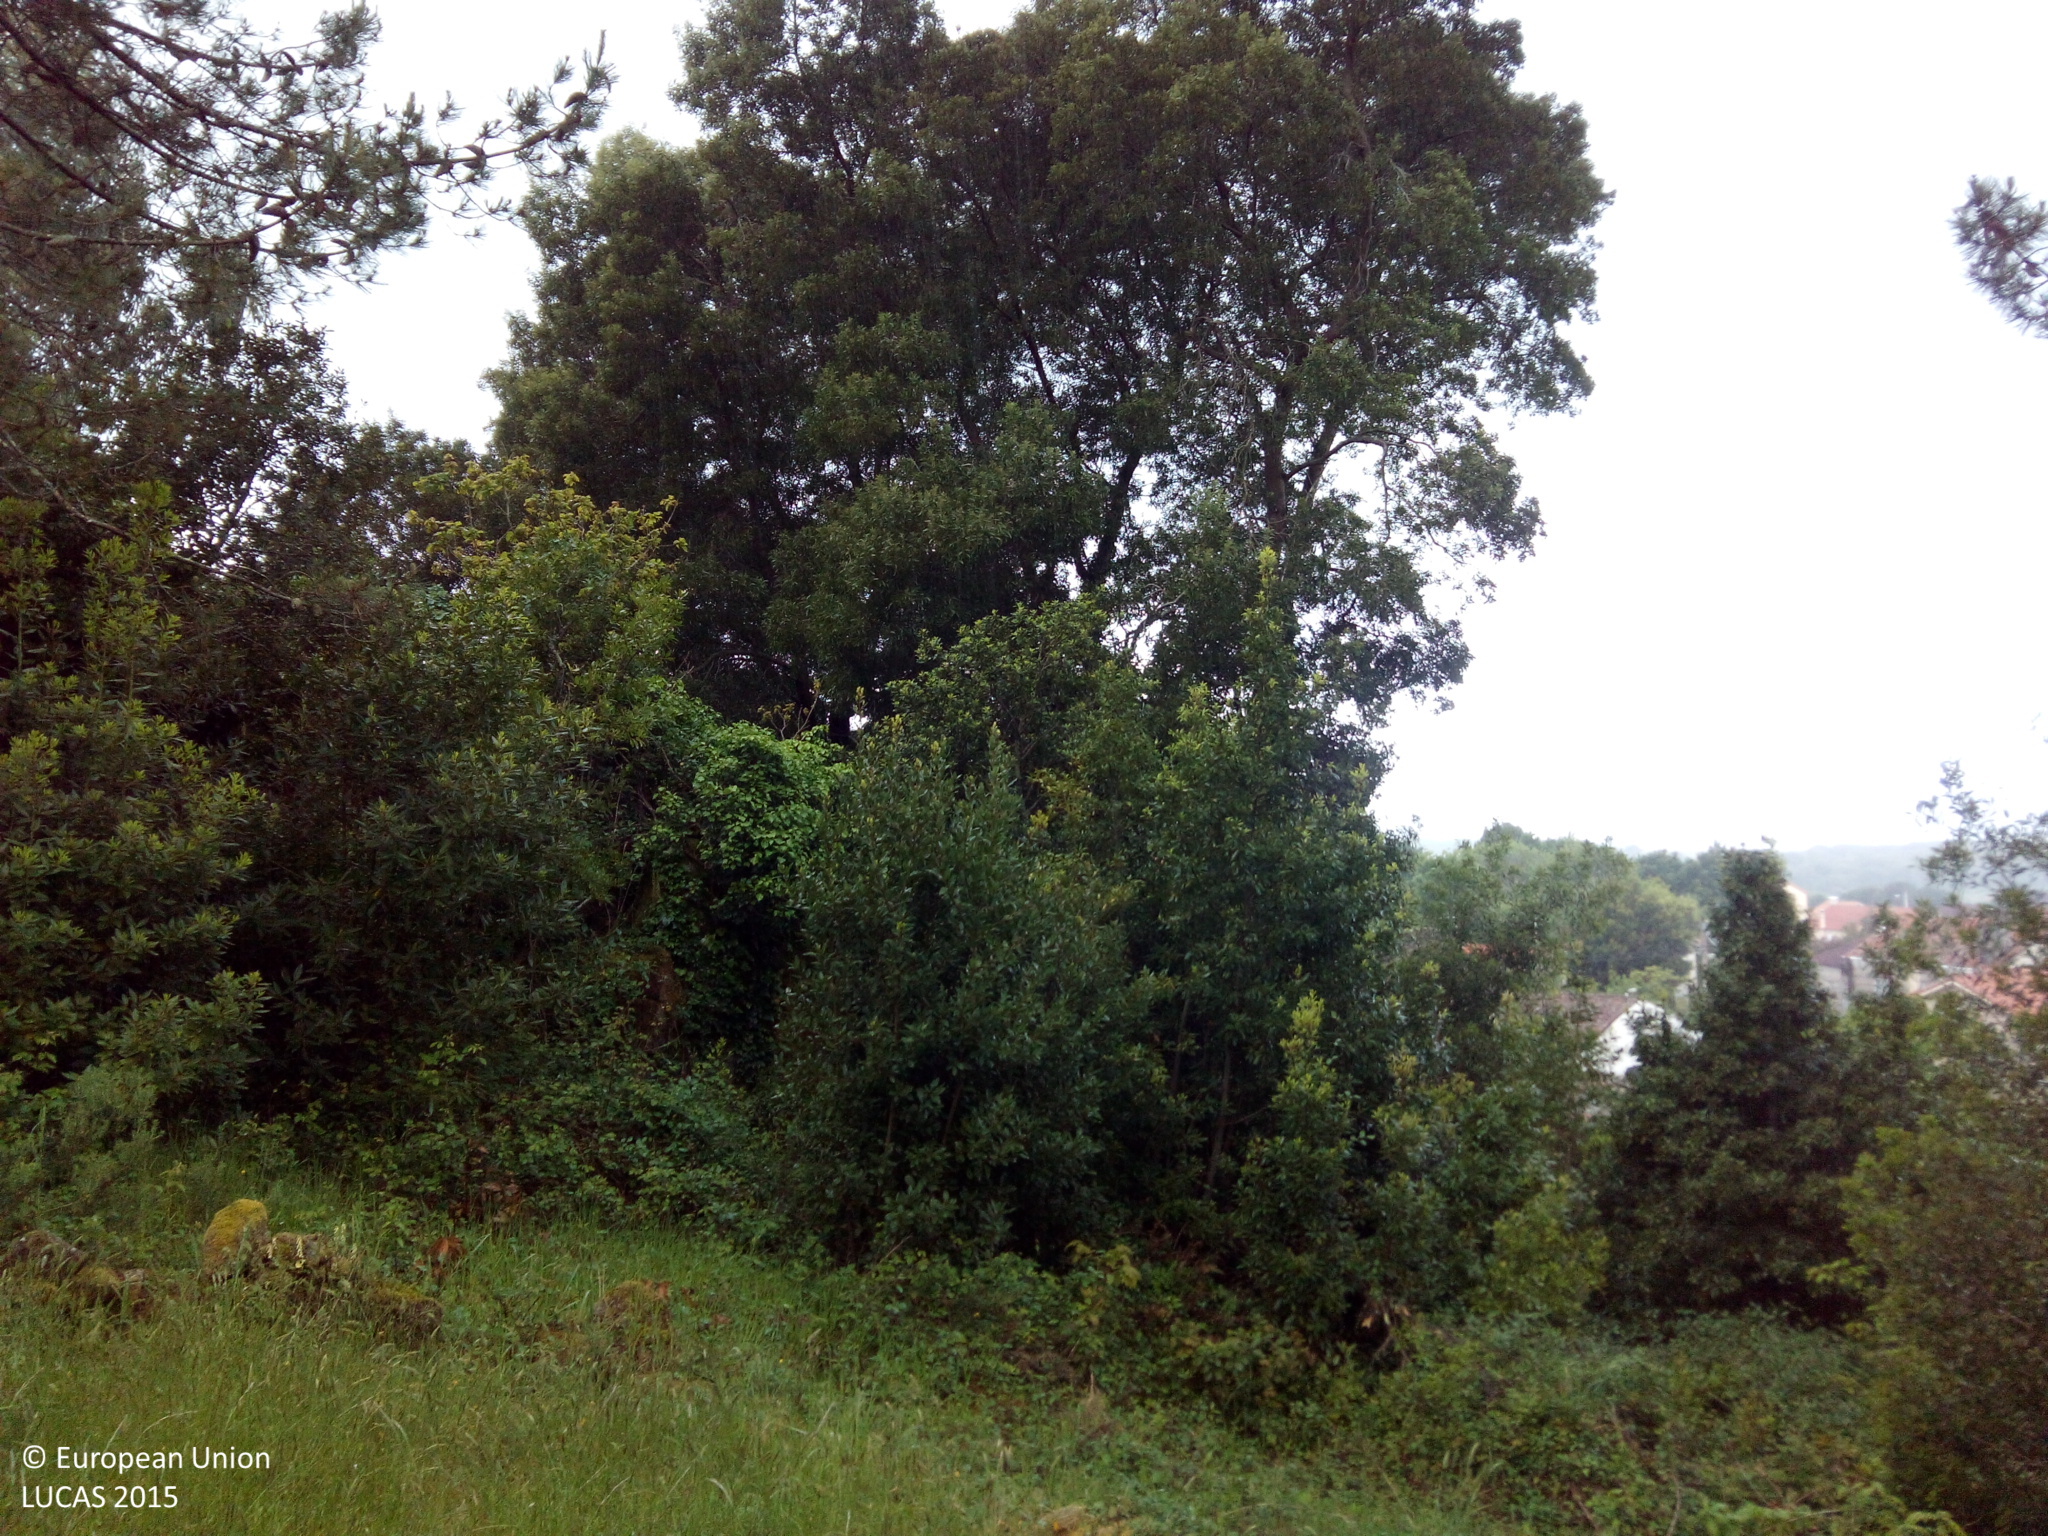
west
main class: Grassland
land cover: Grassland with sparse tree/shrub cover
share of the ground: > 75 %
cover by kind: herbaceous plants 95 %, broadleaved forest trees 5 %
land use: Residential
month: May
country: ES
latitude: 42.8165
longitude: -9.0910
